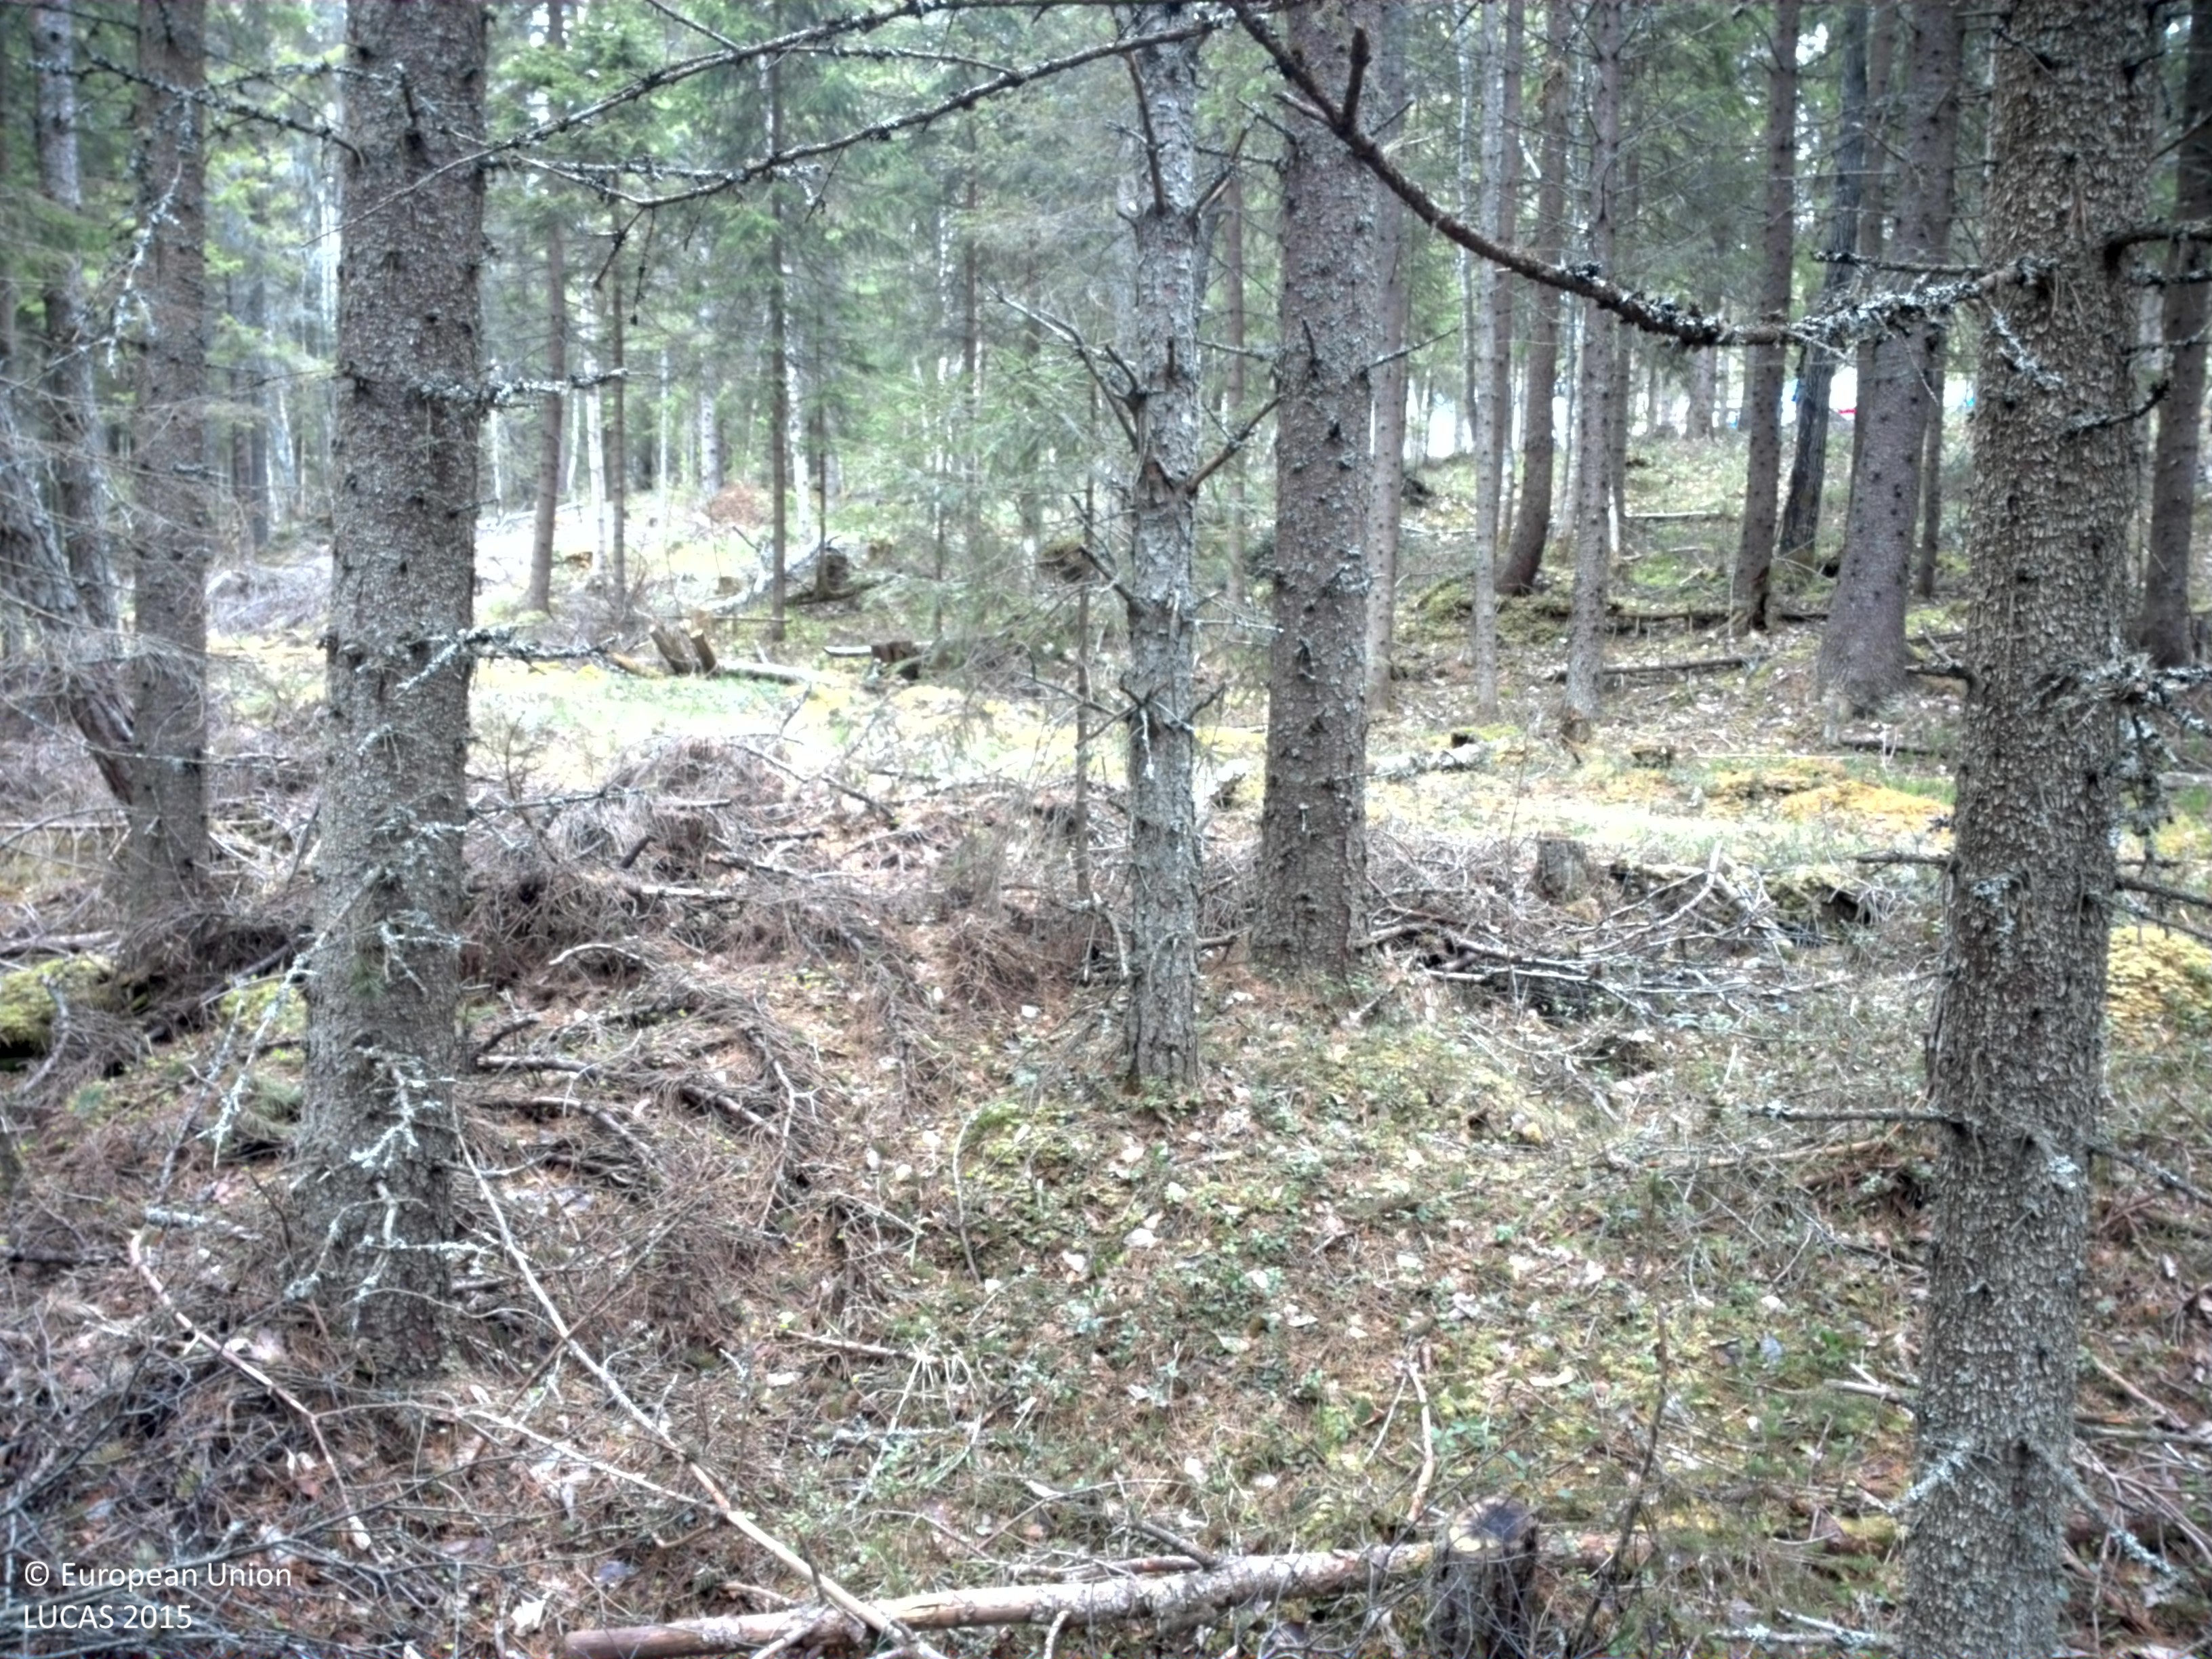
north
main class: Woodland
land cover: Pine dominated mixed woodland
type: boreal forest
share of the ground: > 75 %
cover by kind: coniferous forest trees 60 %, broadleaved forest trees 20 %, lichens and mosses 10 %, shrubs 5 %, herbaceous plants 5 %
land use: Forestry
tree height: > 5 m
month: June
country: SE
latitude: 63.4819
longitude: 13.9347
